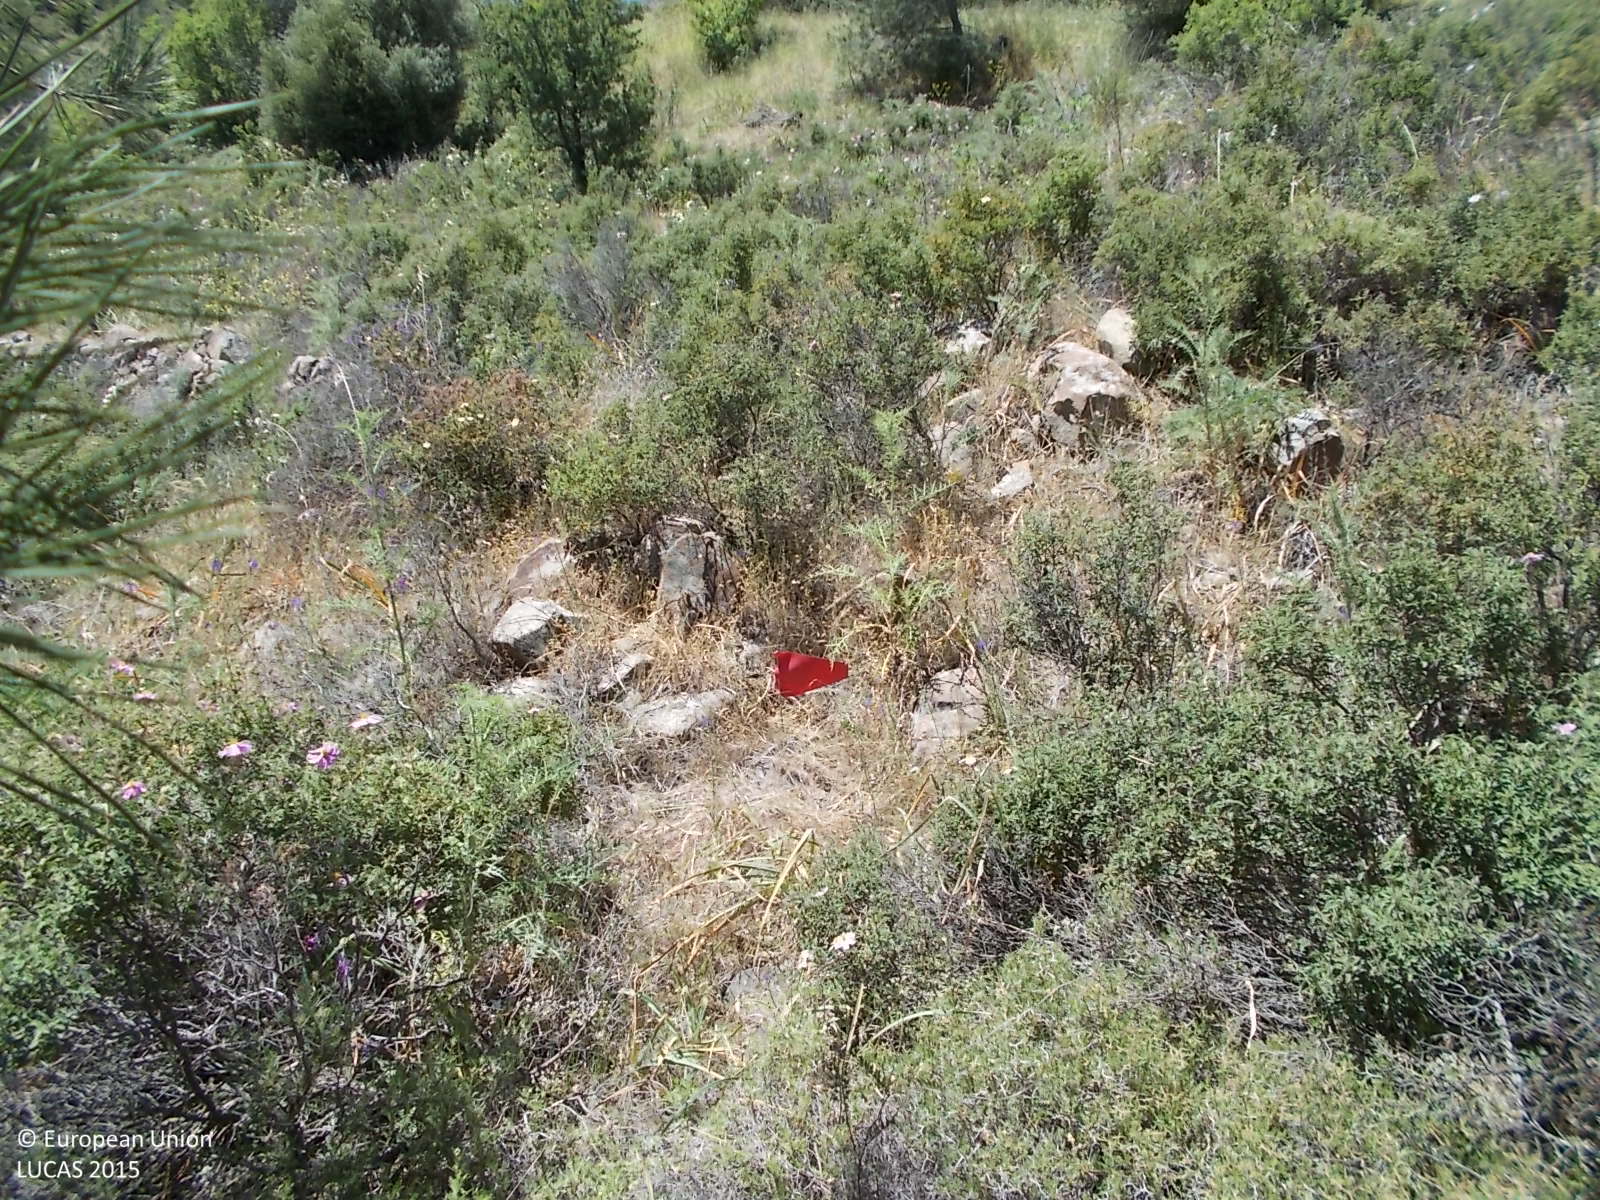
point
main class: Shrubland
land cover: Shrubland with sparse tree cover
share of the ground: > 75 %
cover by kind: shrubs 75 %, unconsolidated bare surface 20 %, coniferous forest trees 5 %
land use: Semi-natural and natural areas not in use
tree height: > 5 m
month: May
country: CY
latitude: 34.9524
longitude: 33.1865
